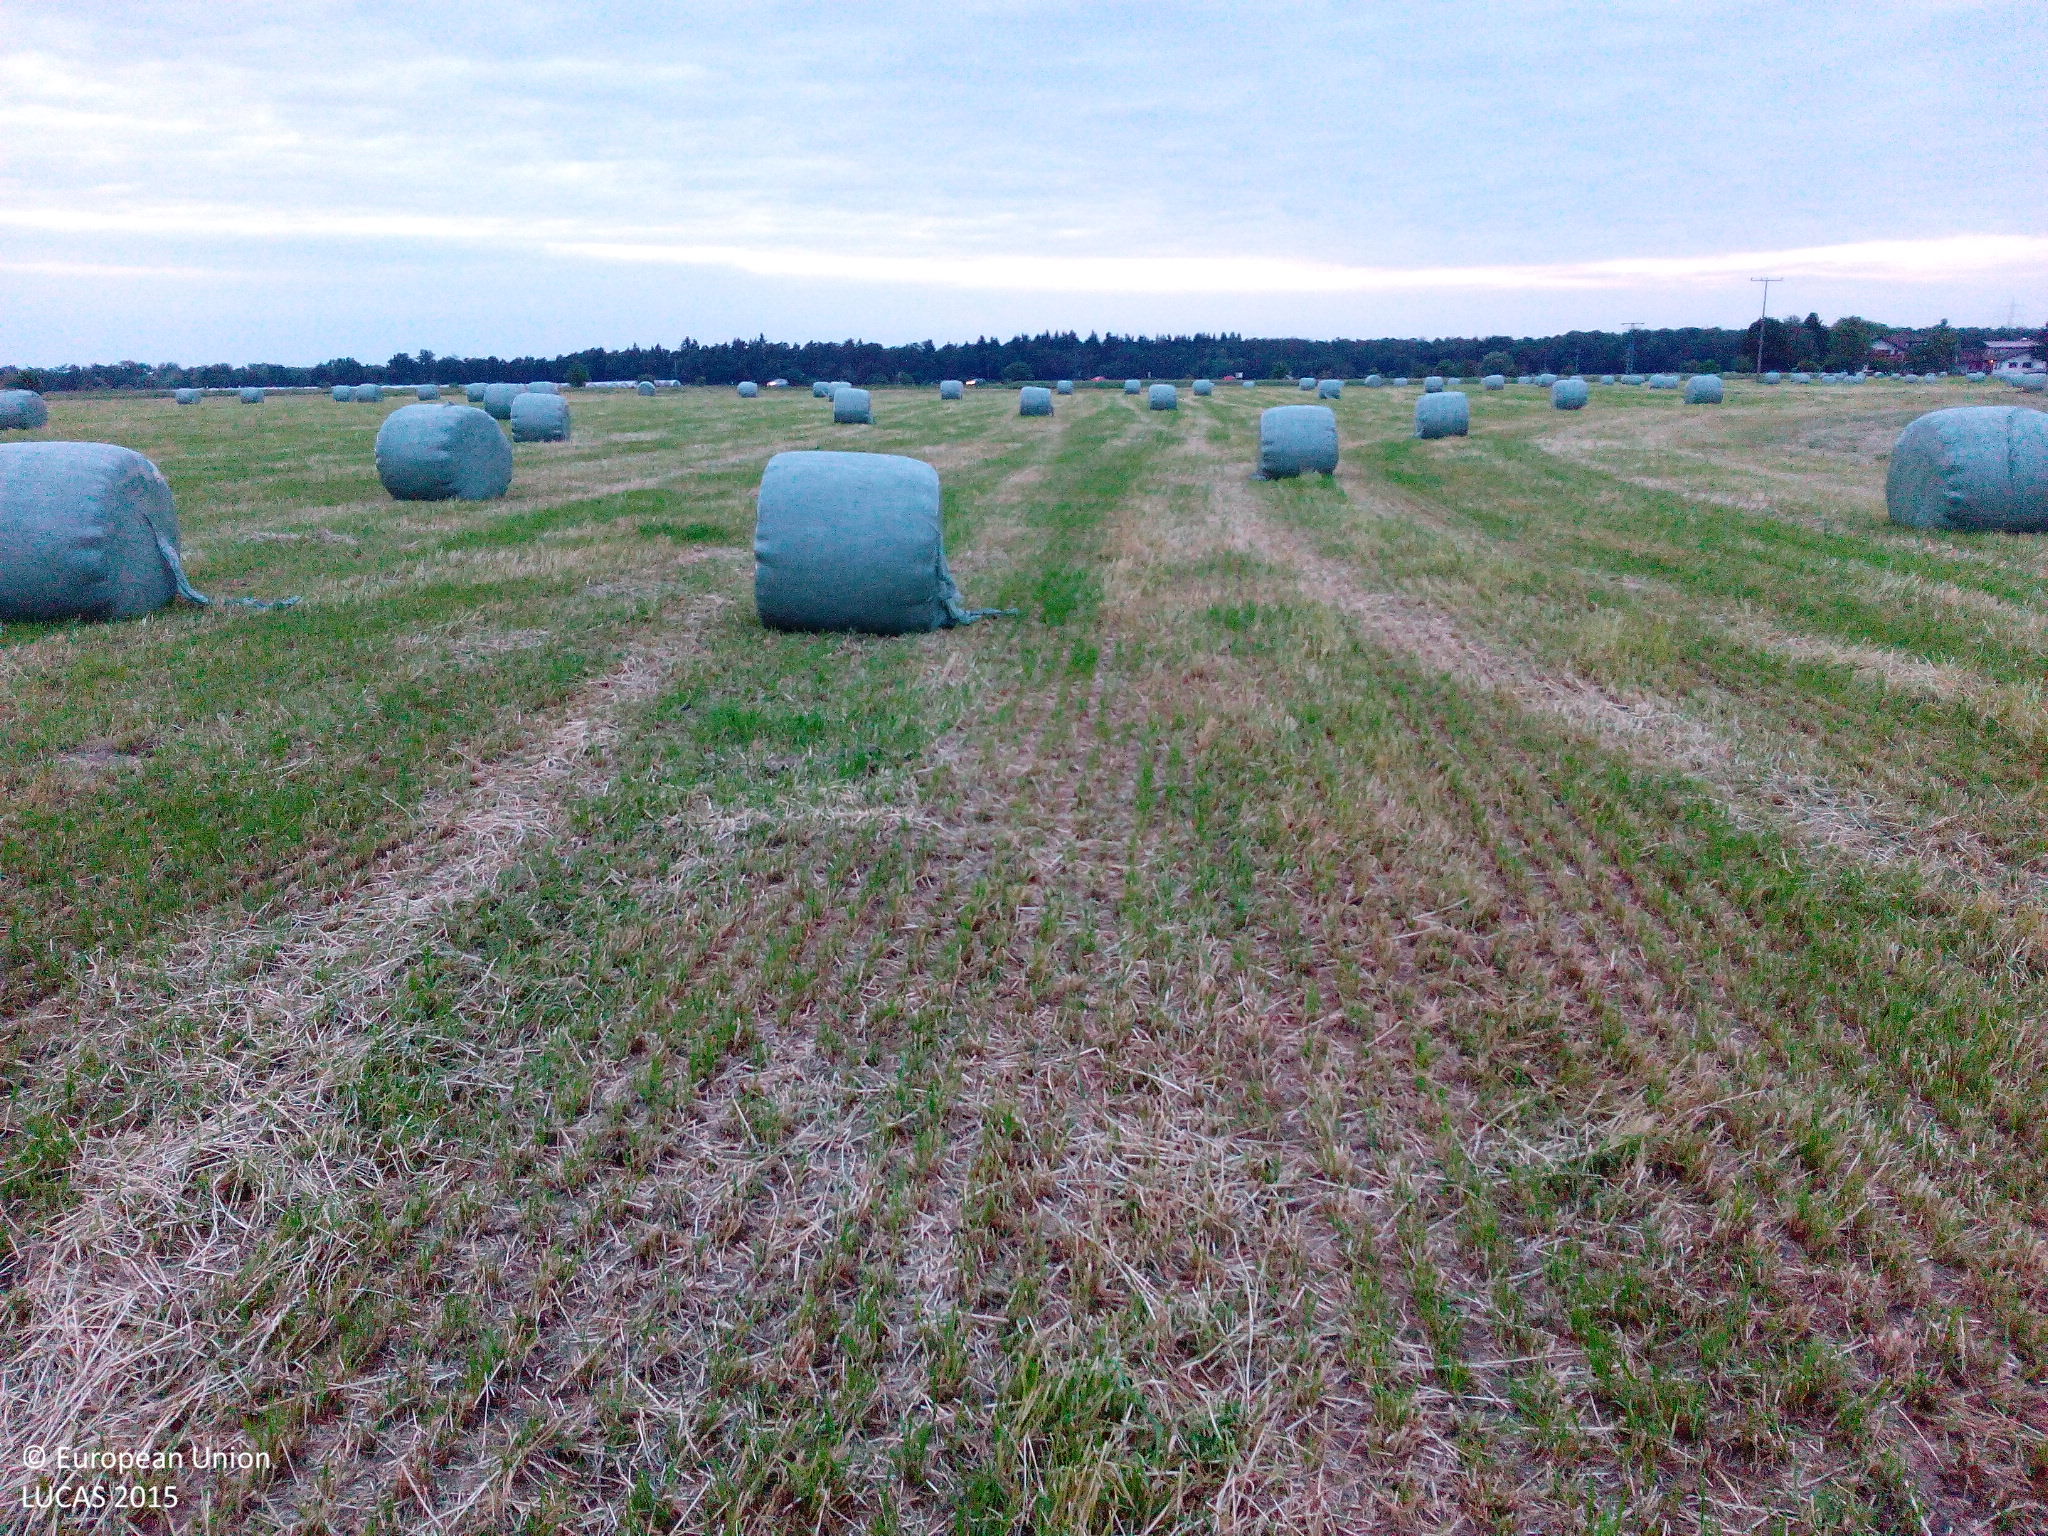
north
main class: Cropland
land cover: Temporary grasslands
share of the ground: 10 - 25 %
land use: Agriculture (excluding fallow land and kitchen gardens)
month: May
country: DE
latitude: 48.8201
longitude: 8.1620
